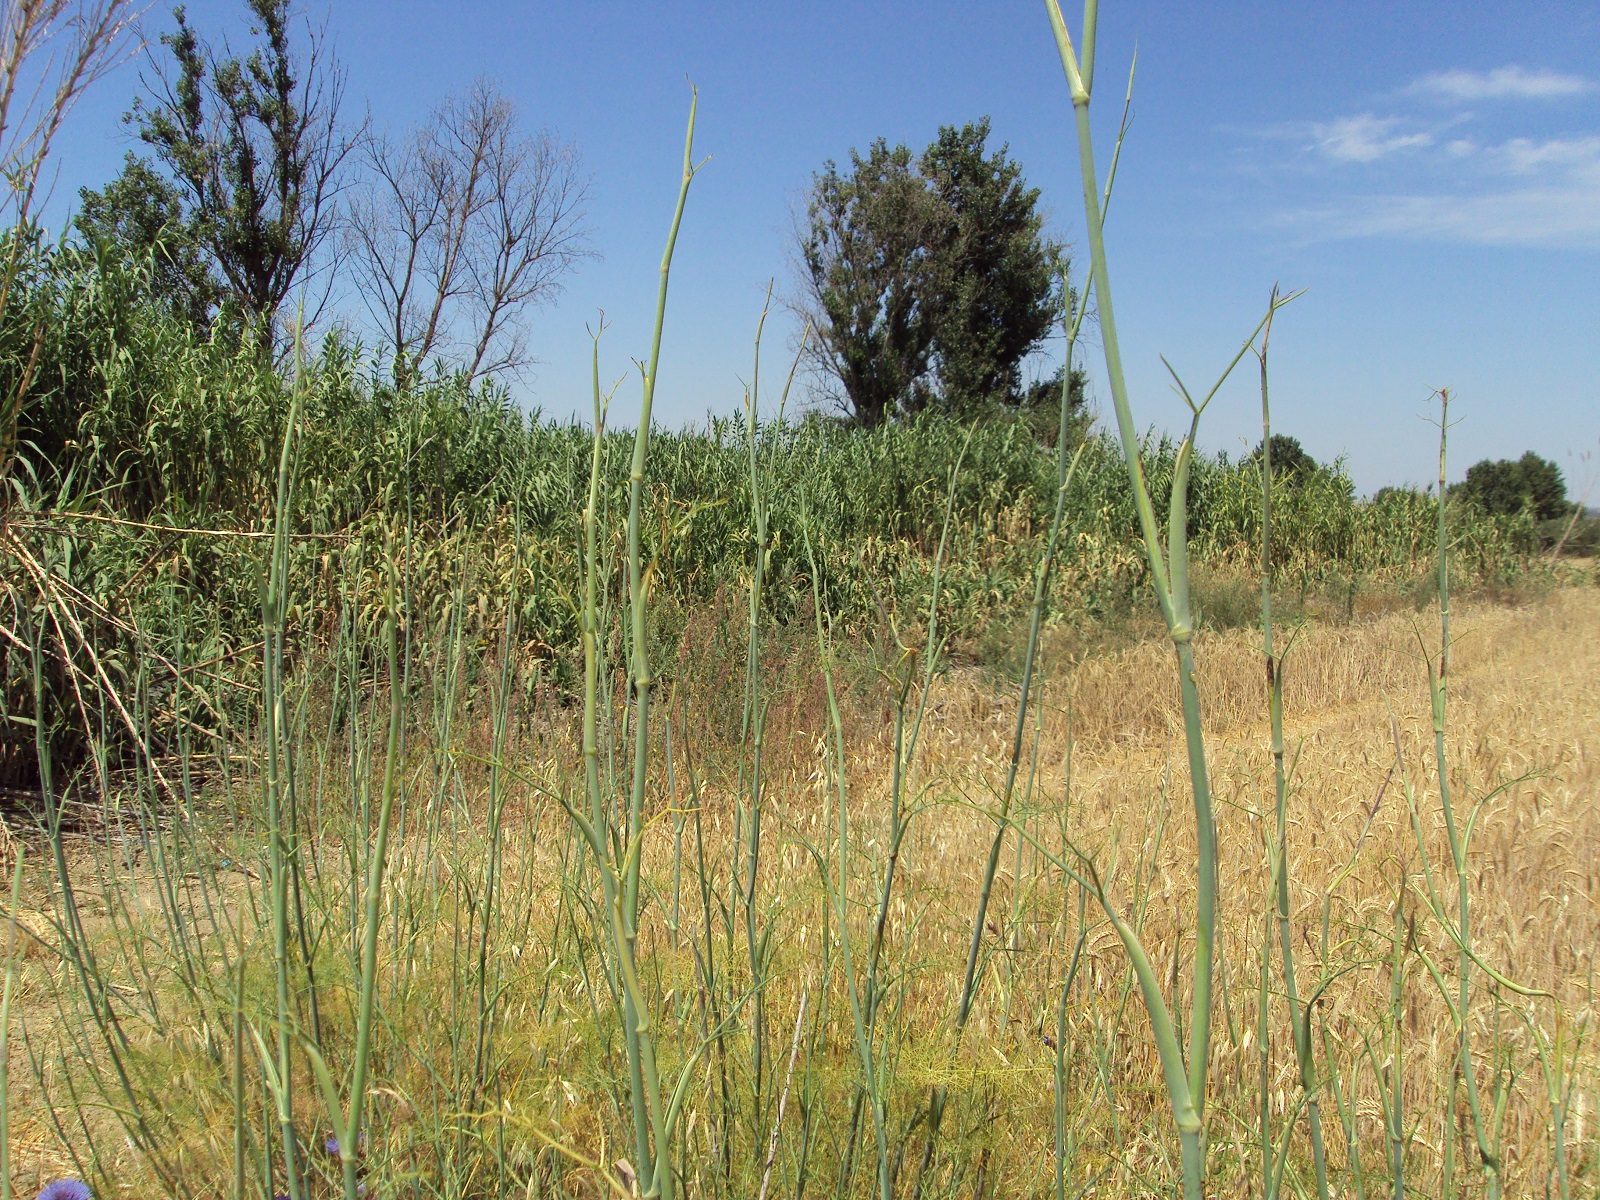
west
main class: Cropland
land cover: Barley
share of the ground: > 75 %
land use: Agriculture (excluding fallow land and kitchen gardens)
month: June
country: ES
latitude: 37.3631
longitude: -6.6205
